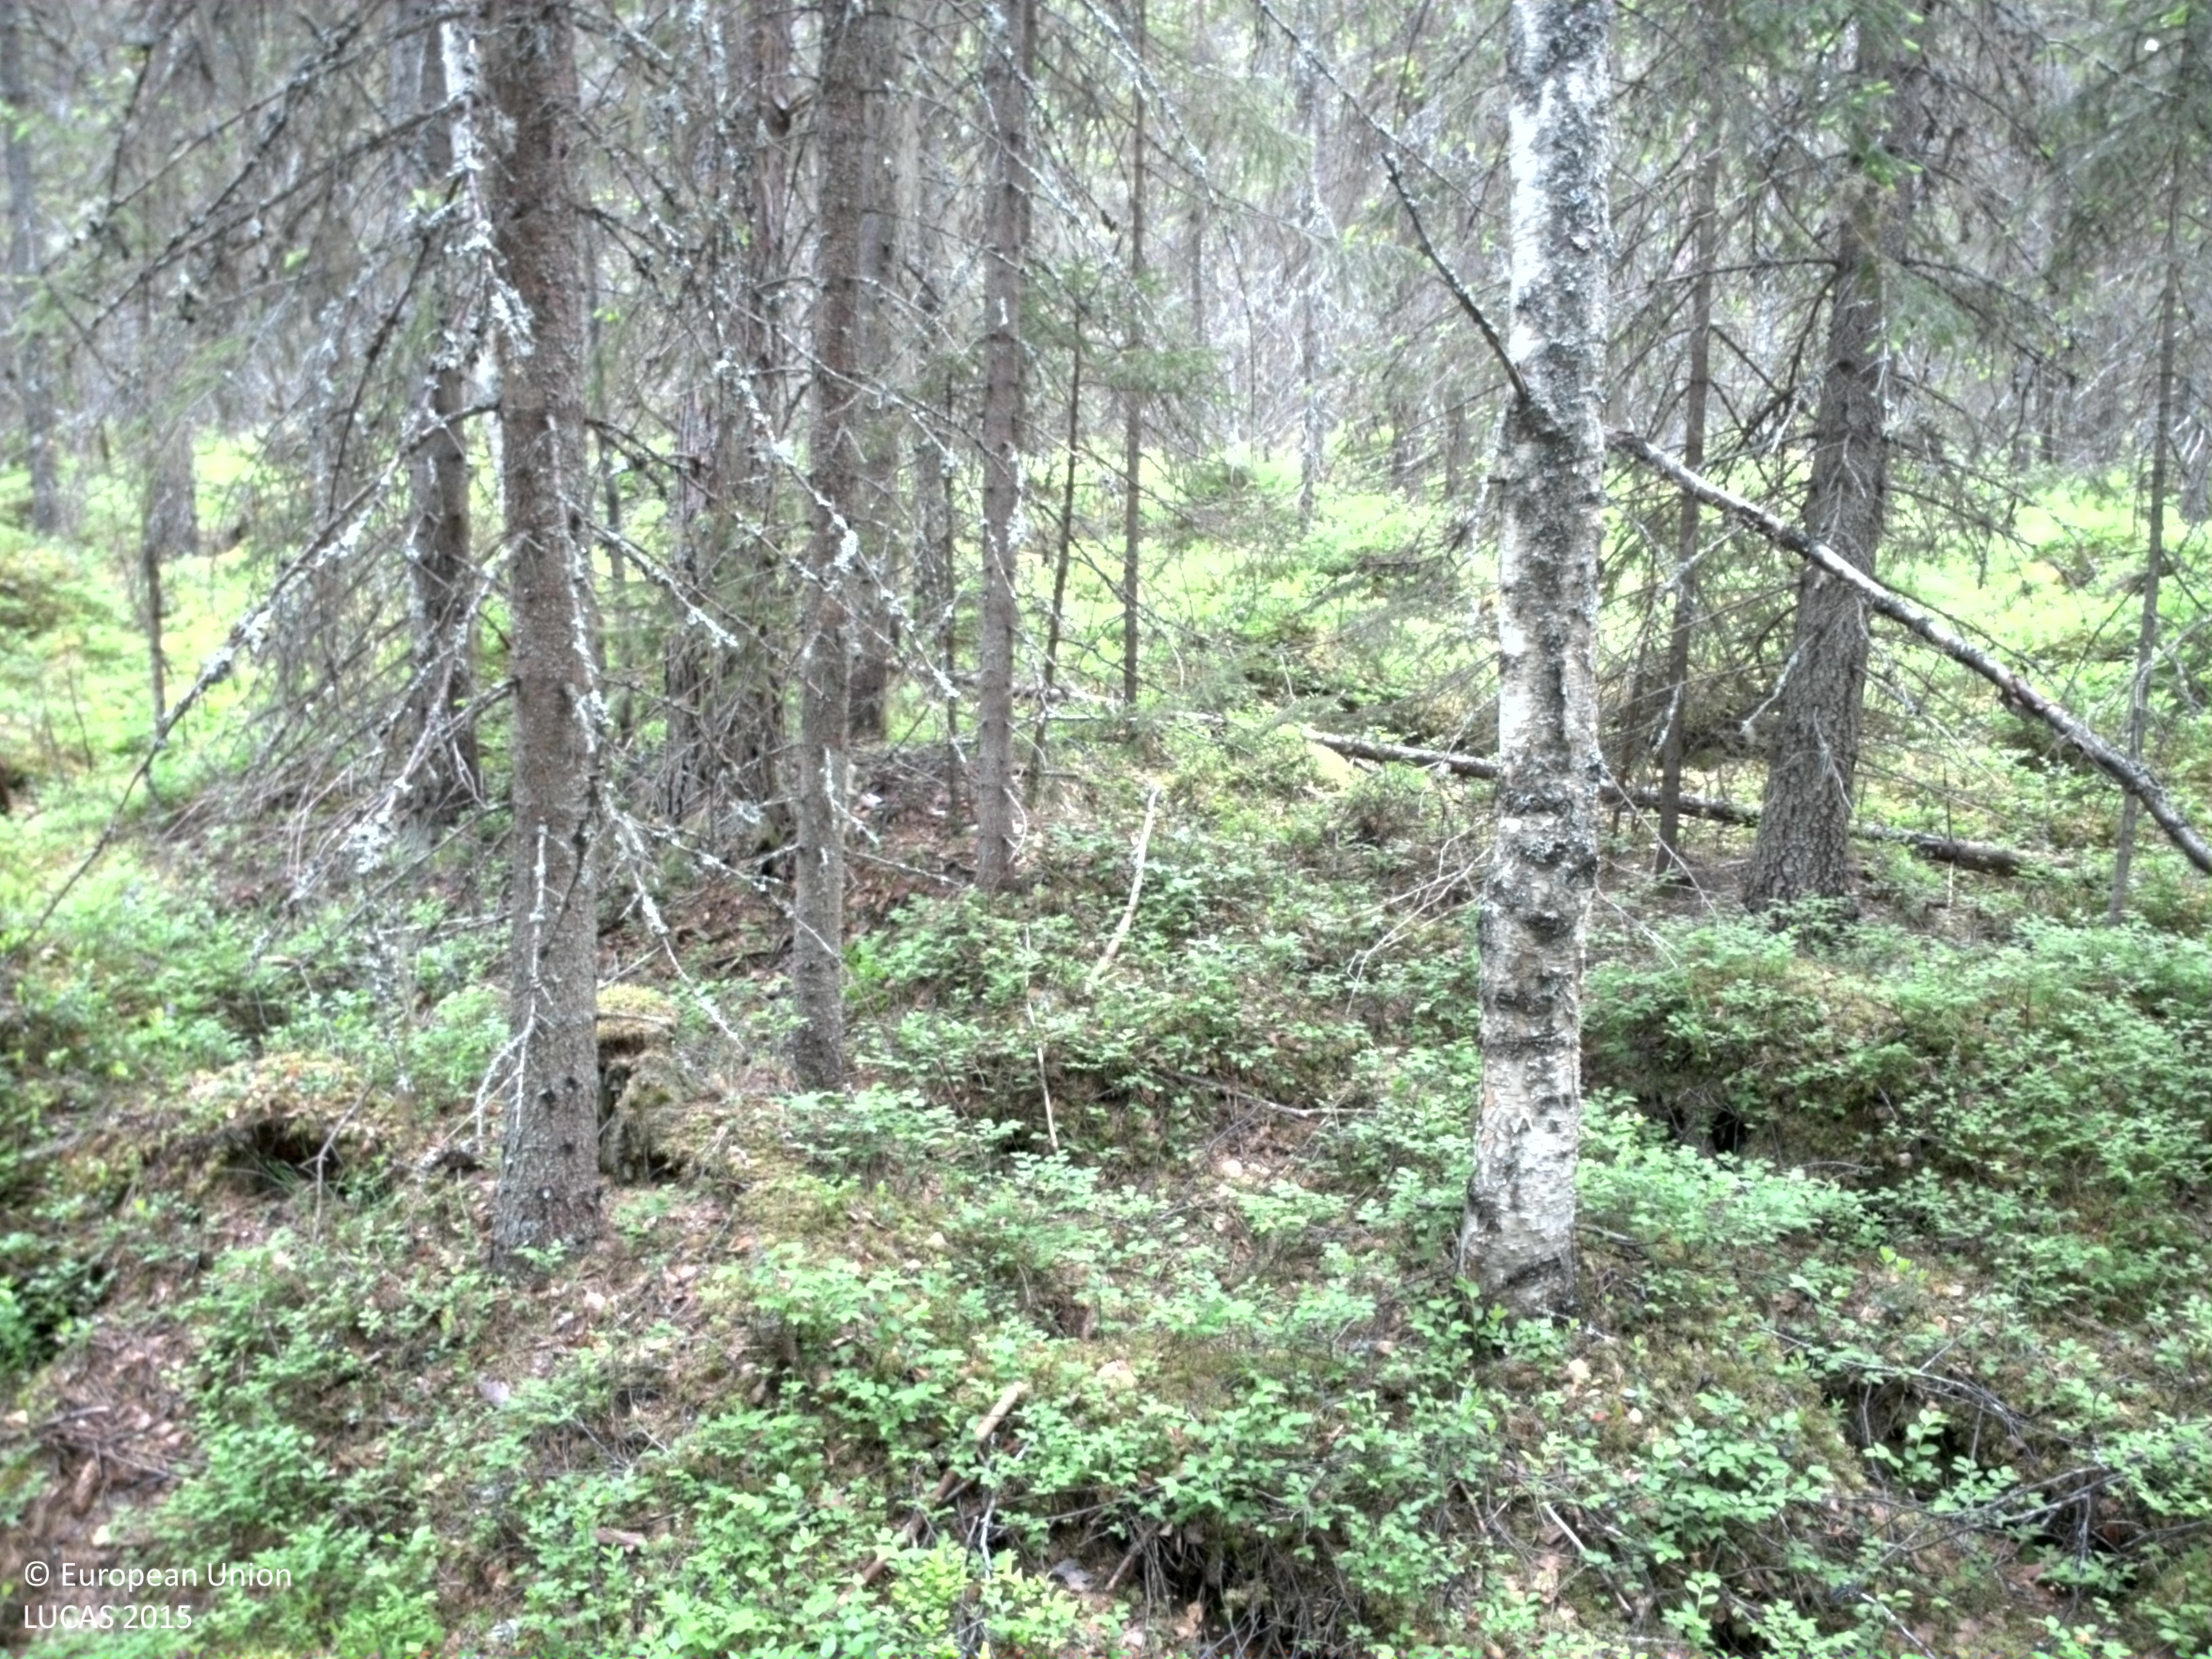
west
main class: Woodland
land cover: Spruce dominated coniferous woodland
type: boreal forest
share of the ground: > 75 %
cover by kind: coniferous forest trees 75 %, broadleaved forest trees 15 %, lichens and mosses 10 %
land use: Forestry
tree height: > 5 m
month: June
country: SE
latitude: 61.1278
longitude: 13.5341
